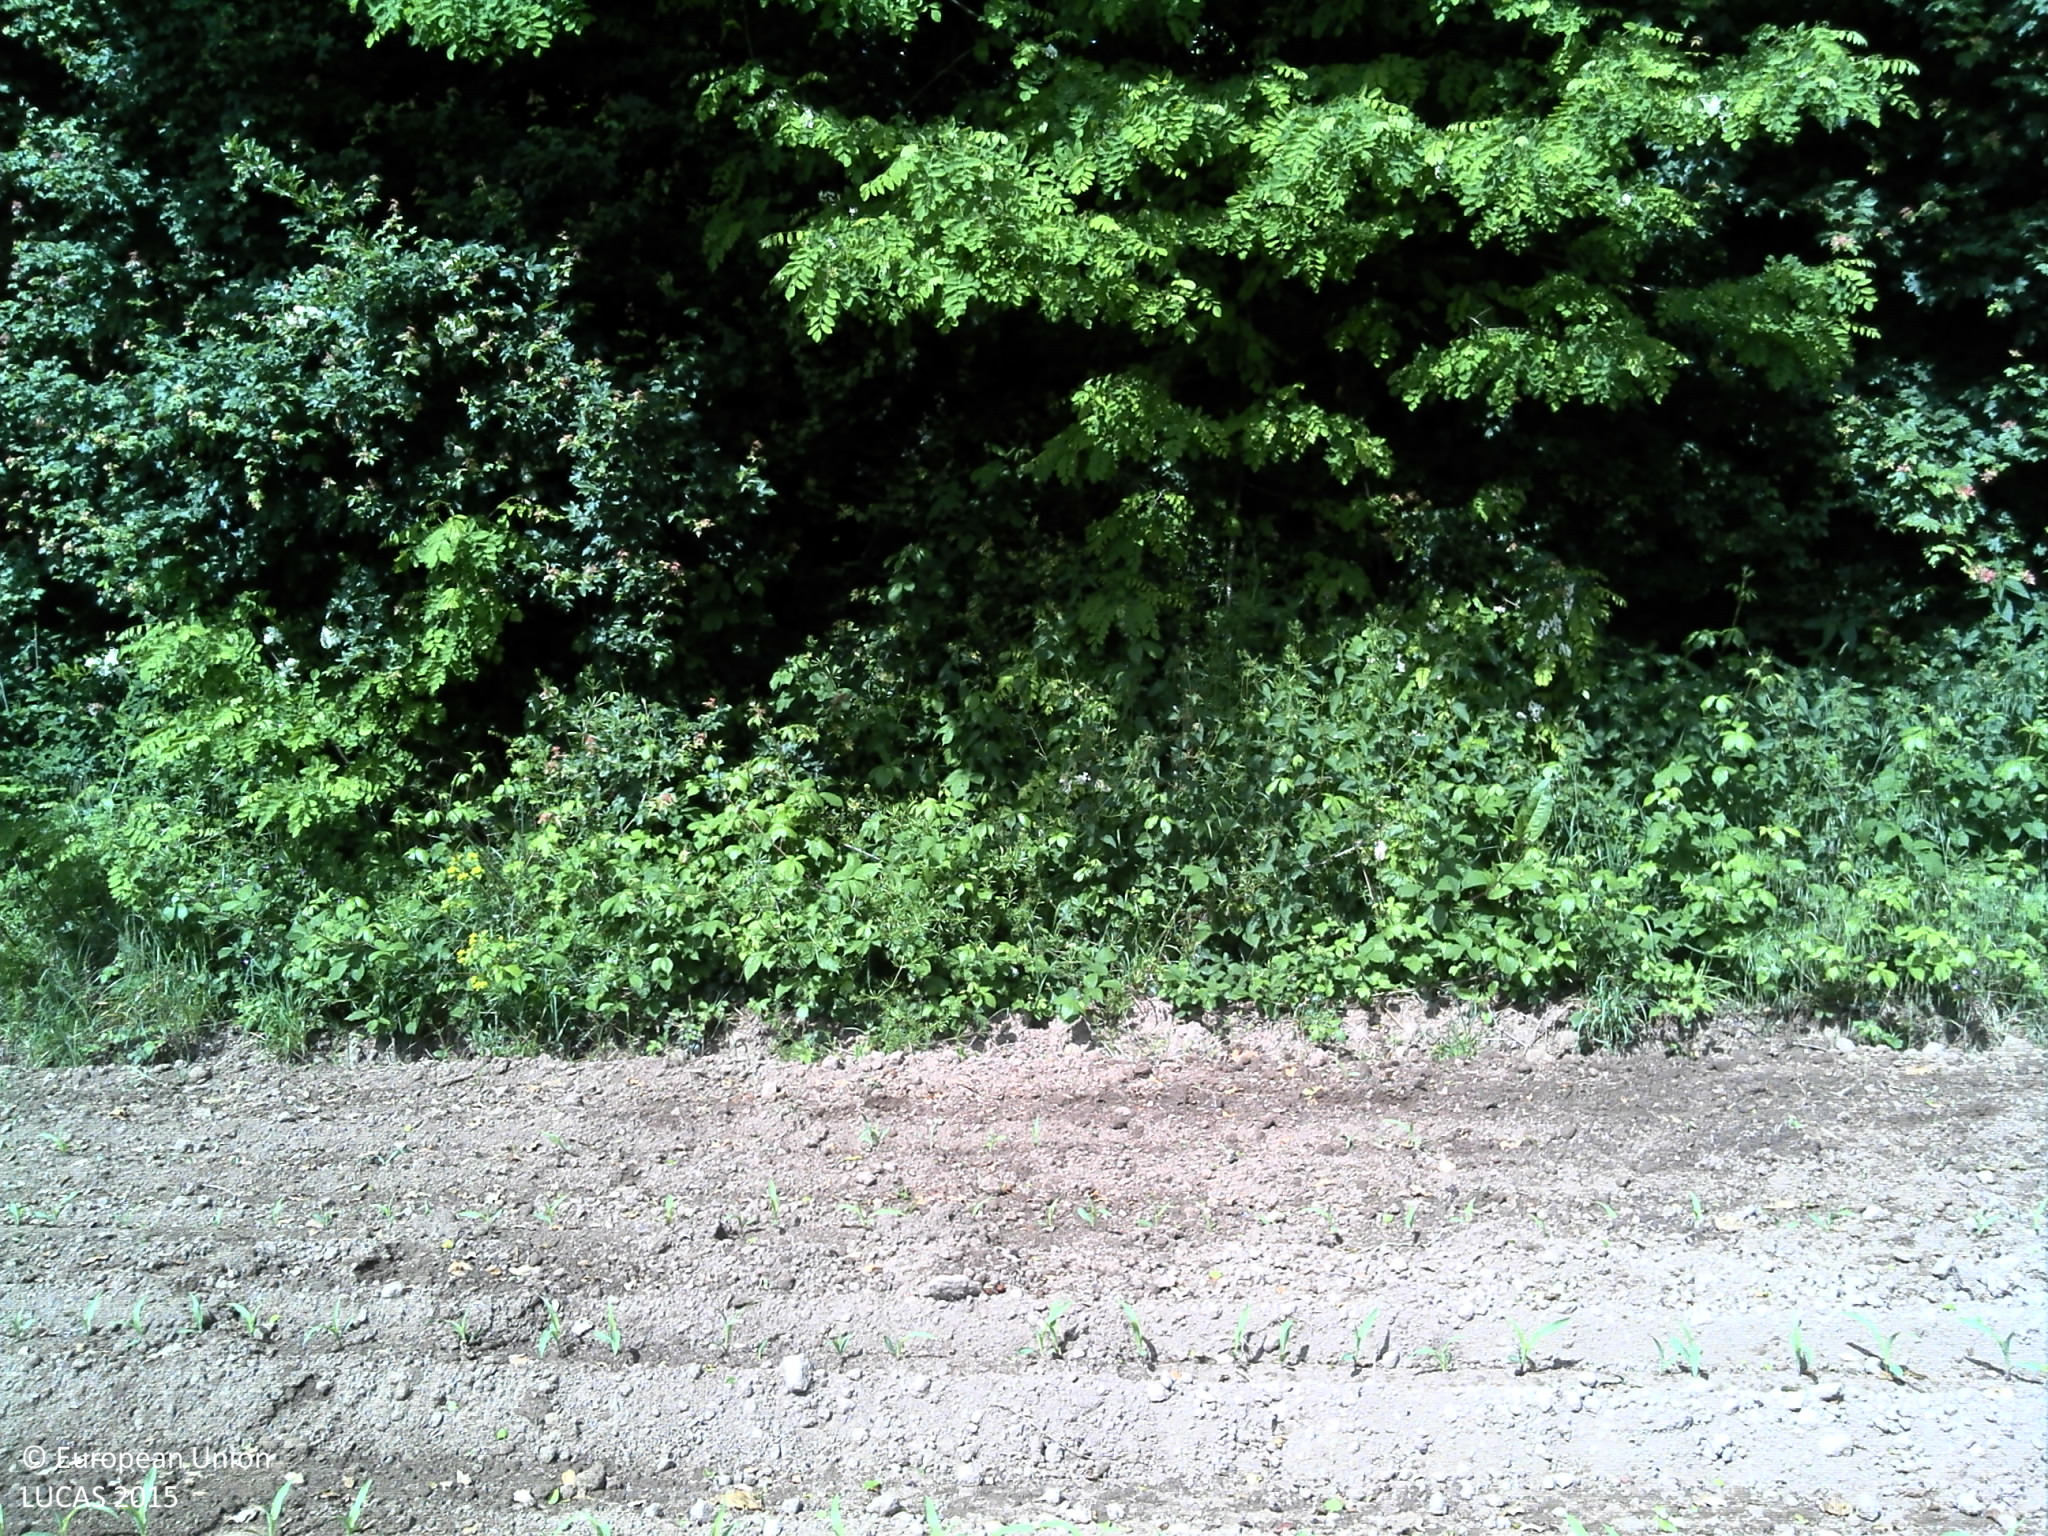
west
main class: Cropland
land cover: Maize
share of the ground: 10 - 25 %
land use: Agriculture (excluding fallow land and kitchen gardens)
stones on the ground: < 10 %
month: June
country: FR
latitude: 47.9145
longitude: -3.5240
